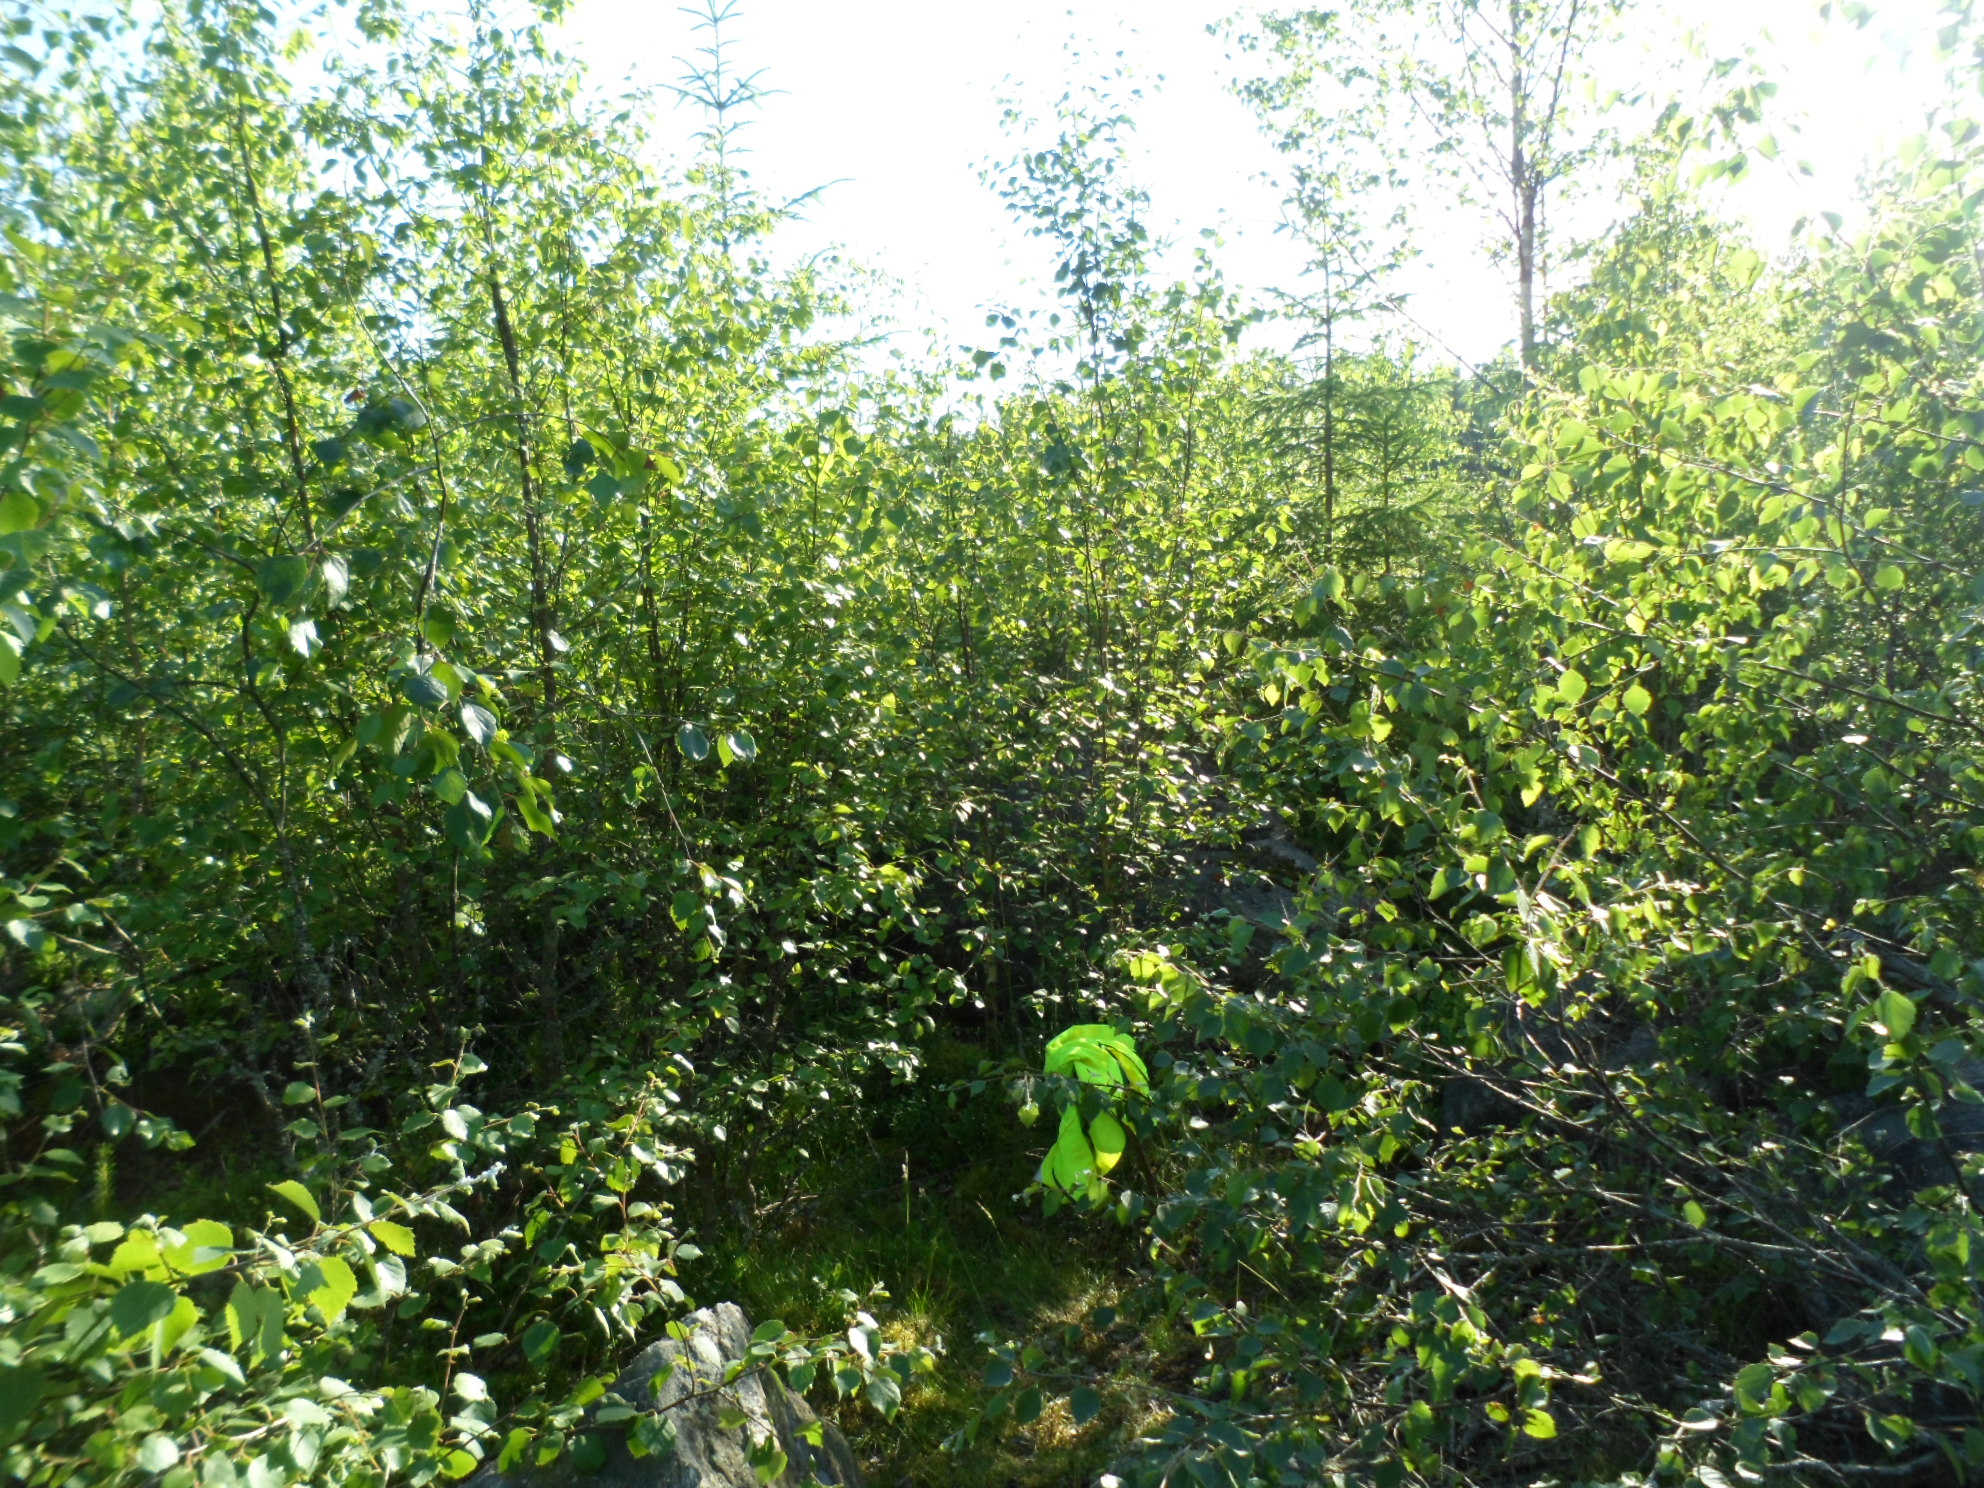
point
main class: Woodland
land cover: Spruce dominated mixed woodland
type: boreal forest
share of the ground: 50 - 75 %
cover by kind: broadleaved forest trees 40 %, coniferous forest trees 35 %, shrubs 10 %, herbaceous plants 10 %, lichens and mosses 5 %
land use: Forestry
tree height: < 5 m
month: July
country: SE
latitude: 57.1206
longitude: 14.4061
